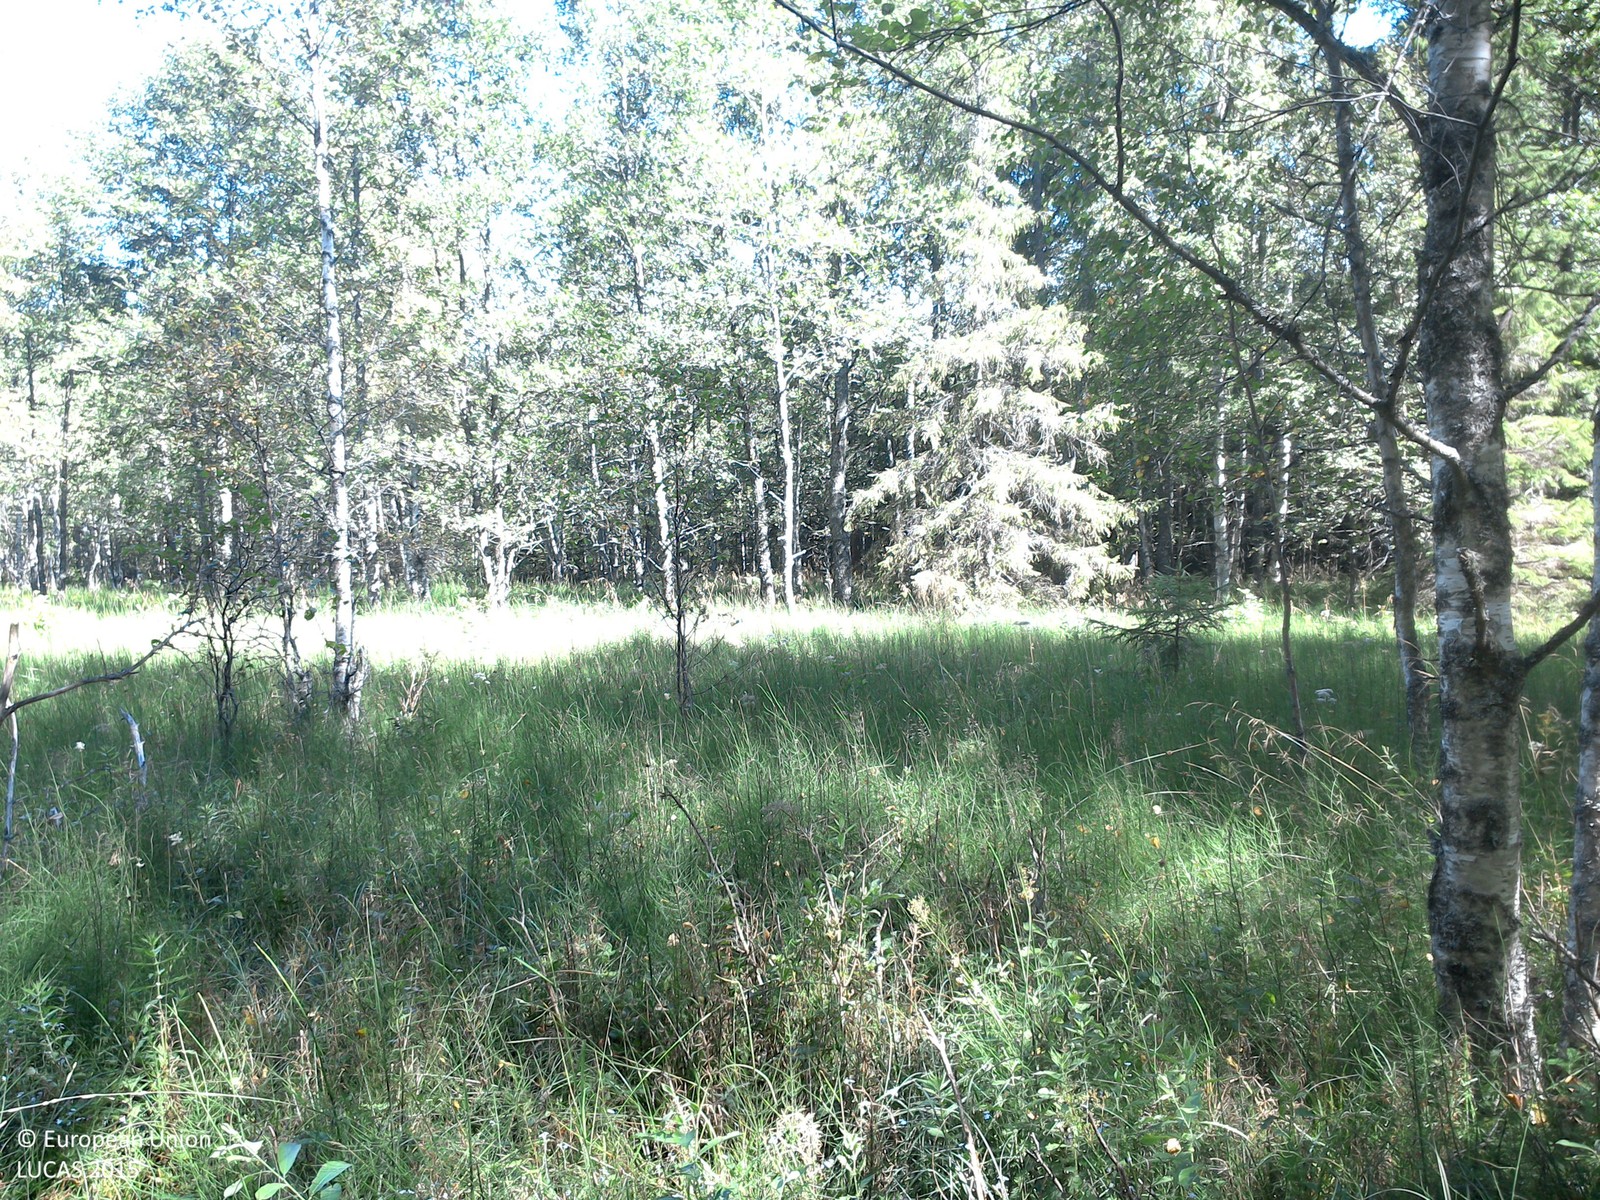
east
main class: Woodland
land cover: Broadleaved woodland
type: mire and swamp forests
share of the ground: 25 - 50 %
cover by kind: herbaceous plants 70 %, broadleaved forest trees 30 %
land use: Forestry
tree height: > 5 m
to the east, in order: Broadleaved woodland; Spruce dominated mixed woodland; Spruce dominated coniferous woodland; Spruce dominated mixed woodland; Broadleaved woodland; Spruce dominated mixed woodland
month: August
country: SE
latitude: 57.9108
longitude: 15.4471
